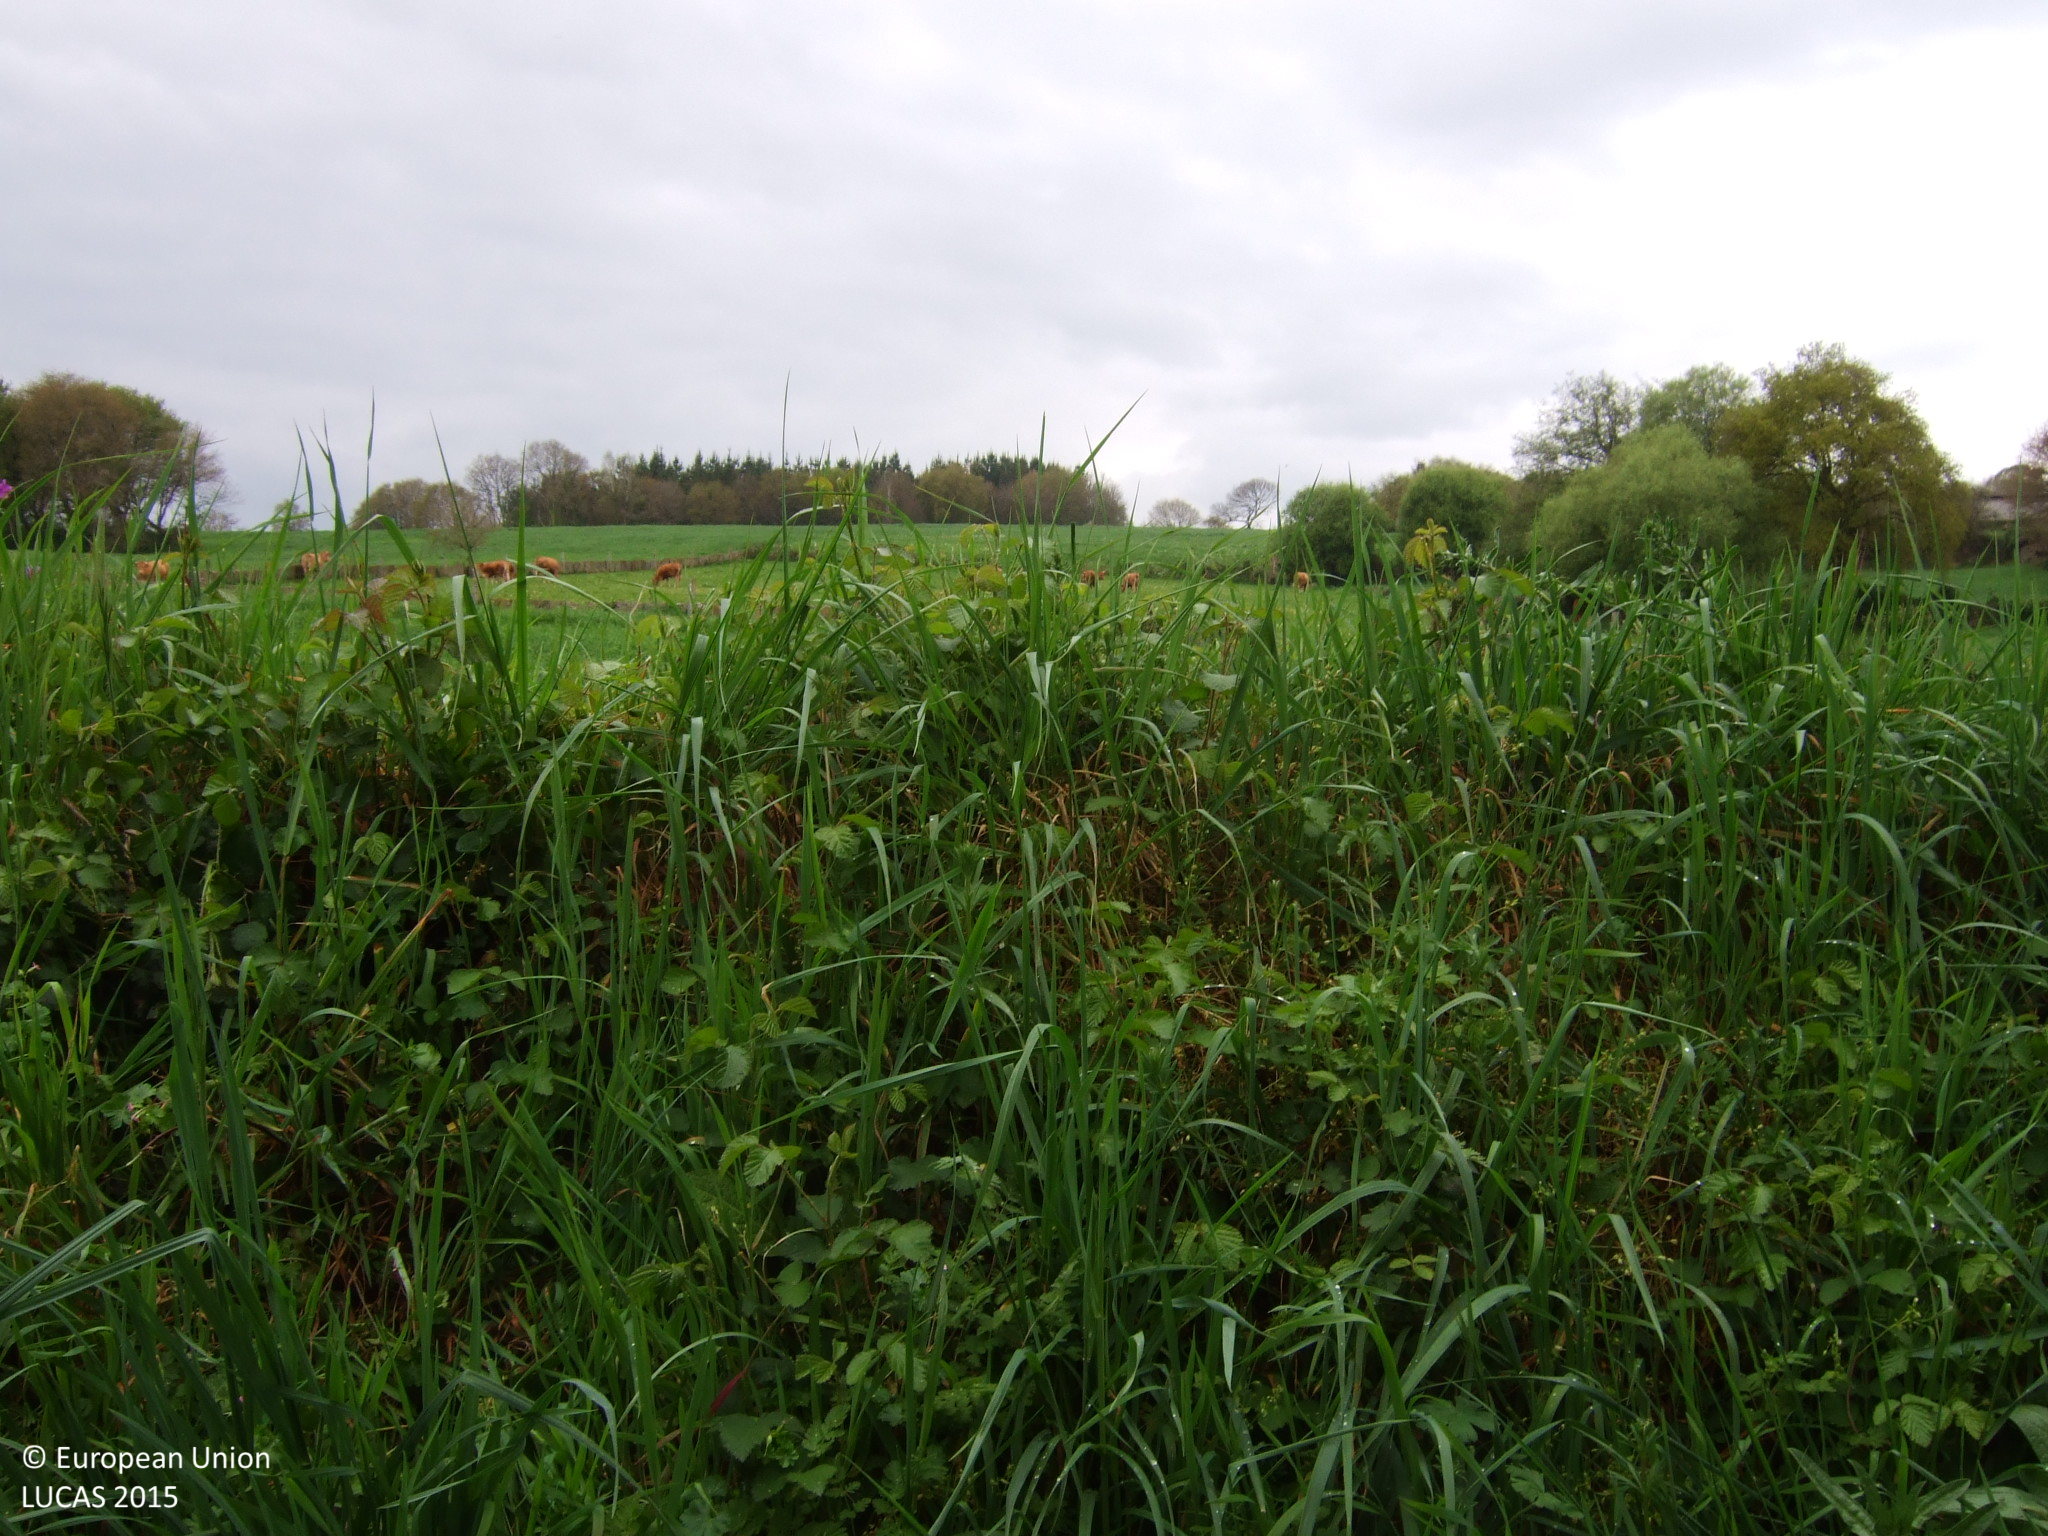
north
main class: Cropland
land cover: Apple fruit
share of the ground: 25 - 50 %
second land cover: Spontaneously vegetated surfaces
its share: > 75 %
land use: Kitchen garden
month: April
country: ES
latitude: 42.8914
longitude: -7.5746
